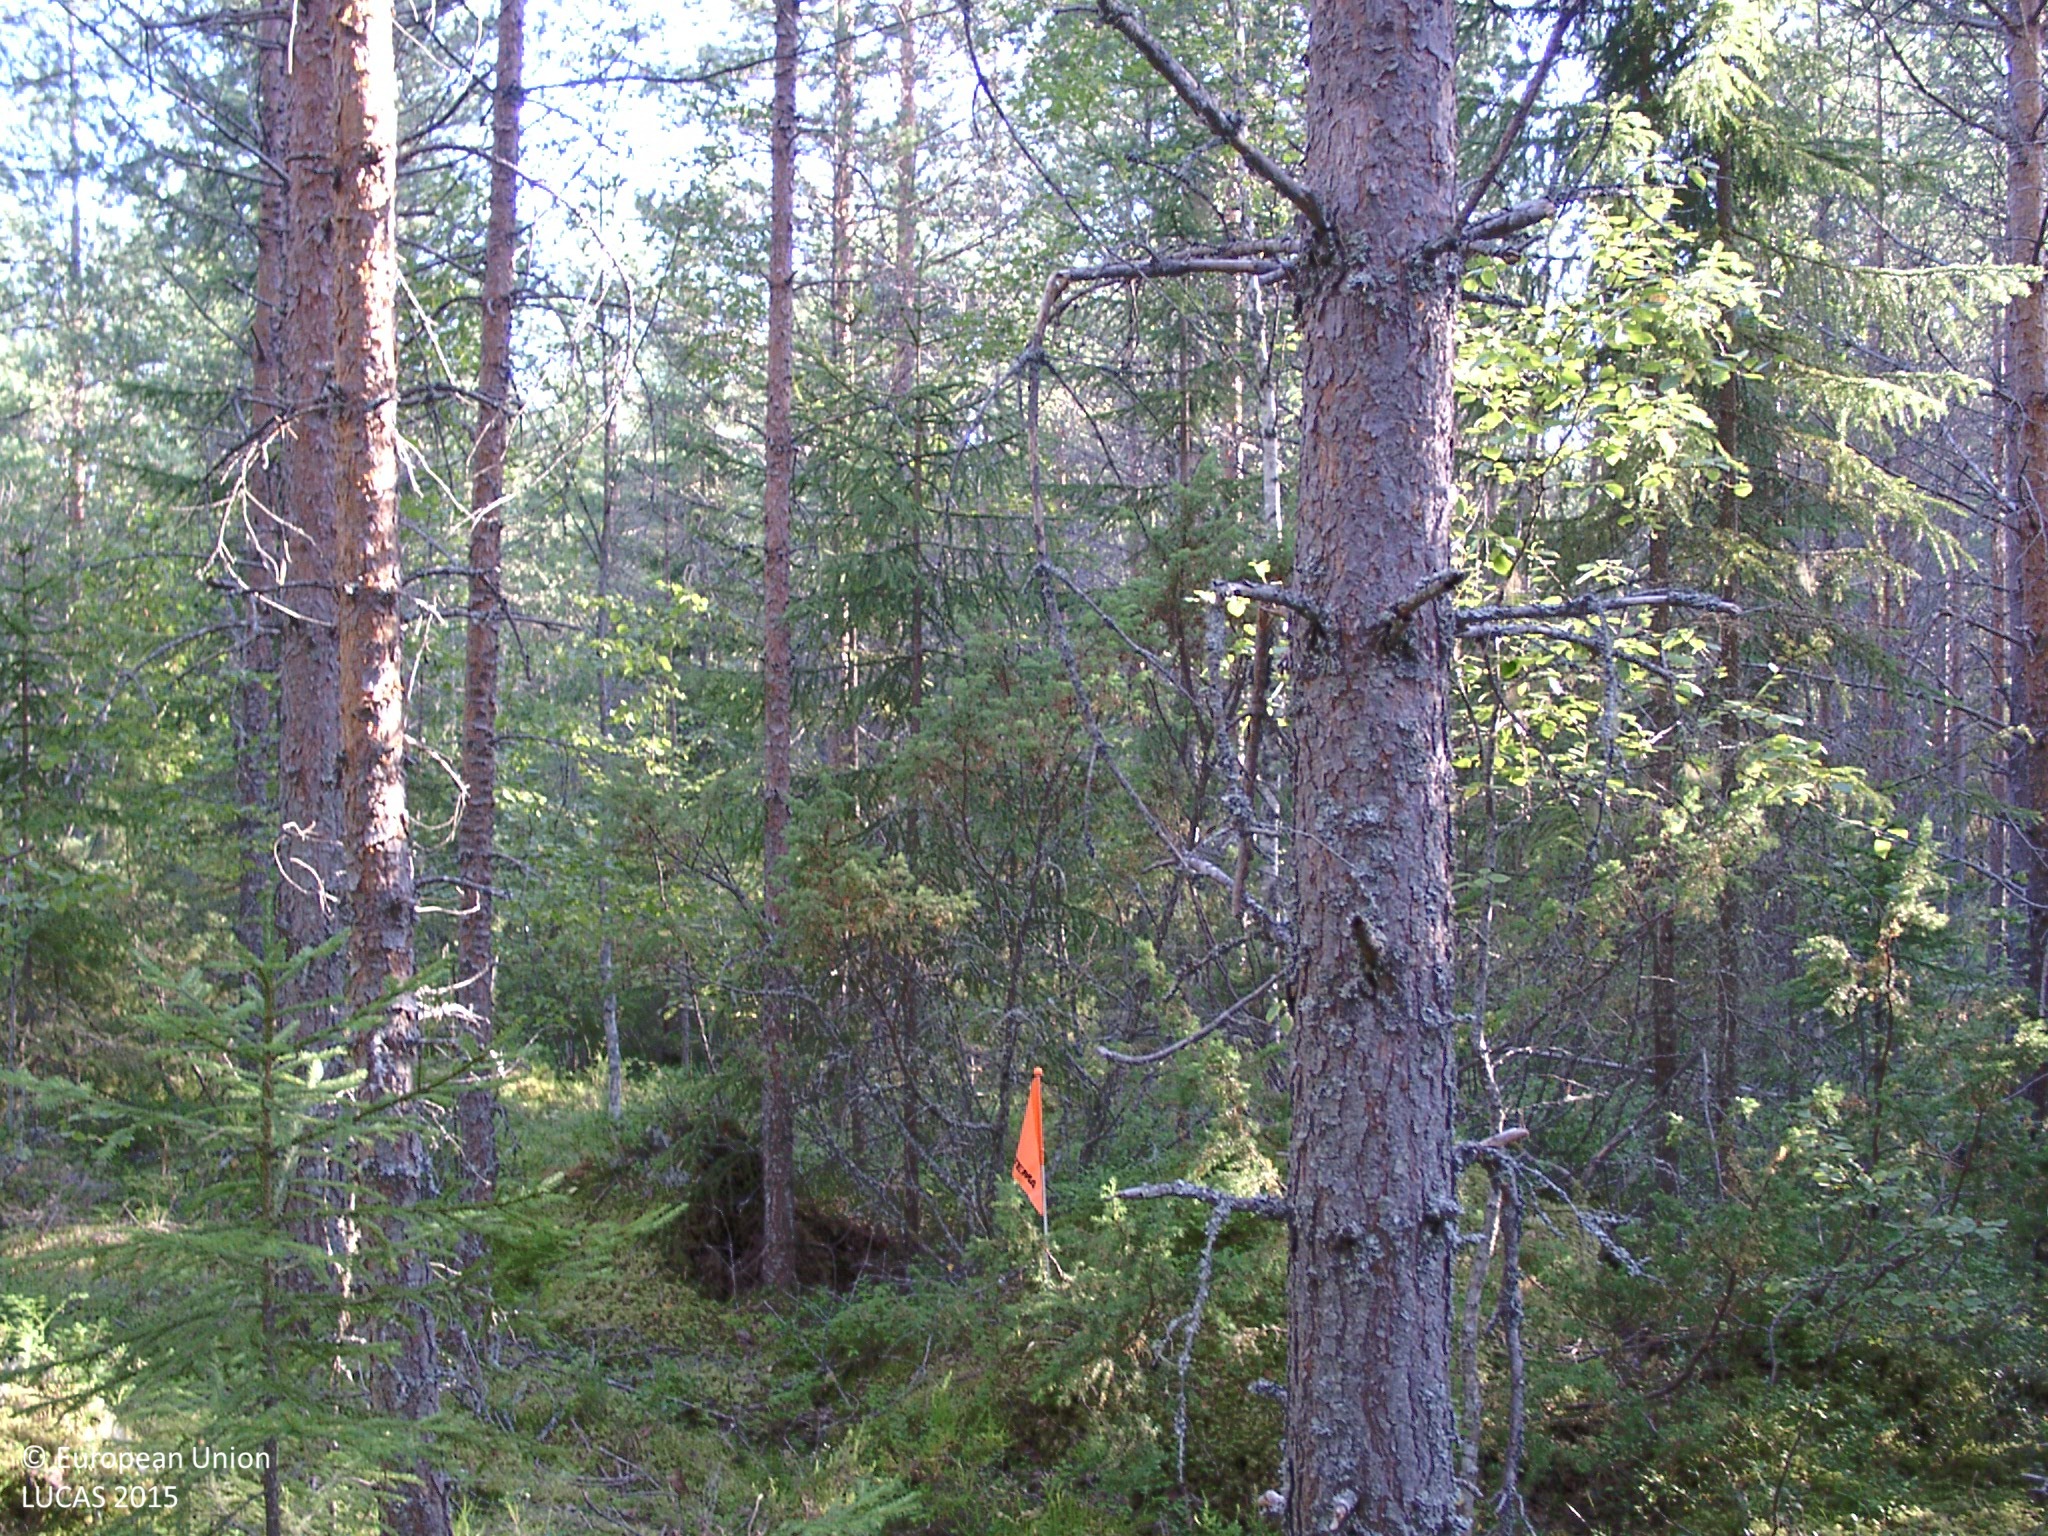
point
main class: Woodland
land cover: Pine dominated mixed woodland
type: boreal forest
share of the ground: 50 - 75 %
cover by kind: coniferous forest trees 50 %, broadleaved forest trees 20 %, shrubs 15 %, lichens and mosses 15 %
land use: Forestry
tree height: > 5 m
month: August
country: FI
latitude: 62.9115
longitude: 25.1178
